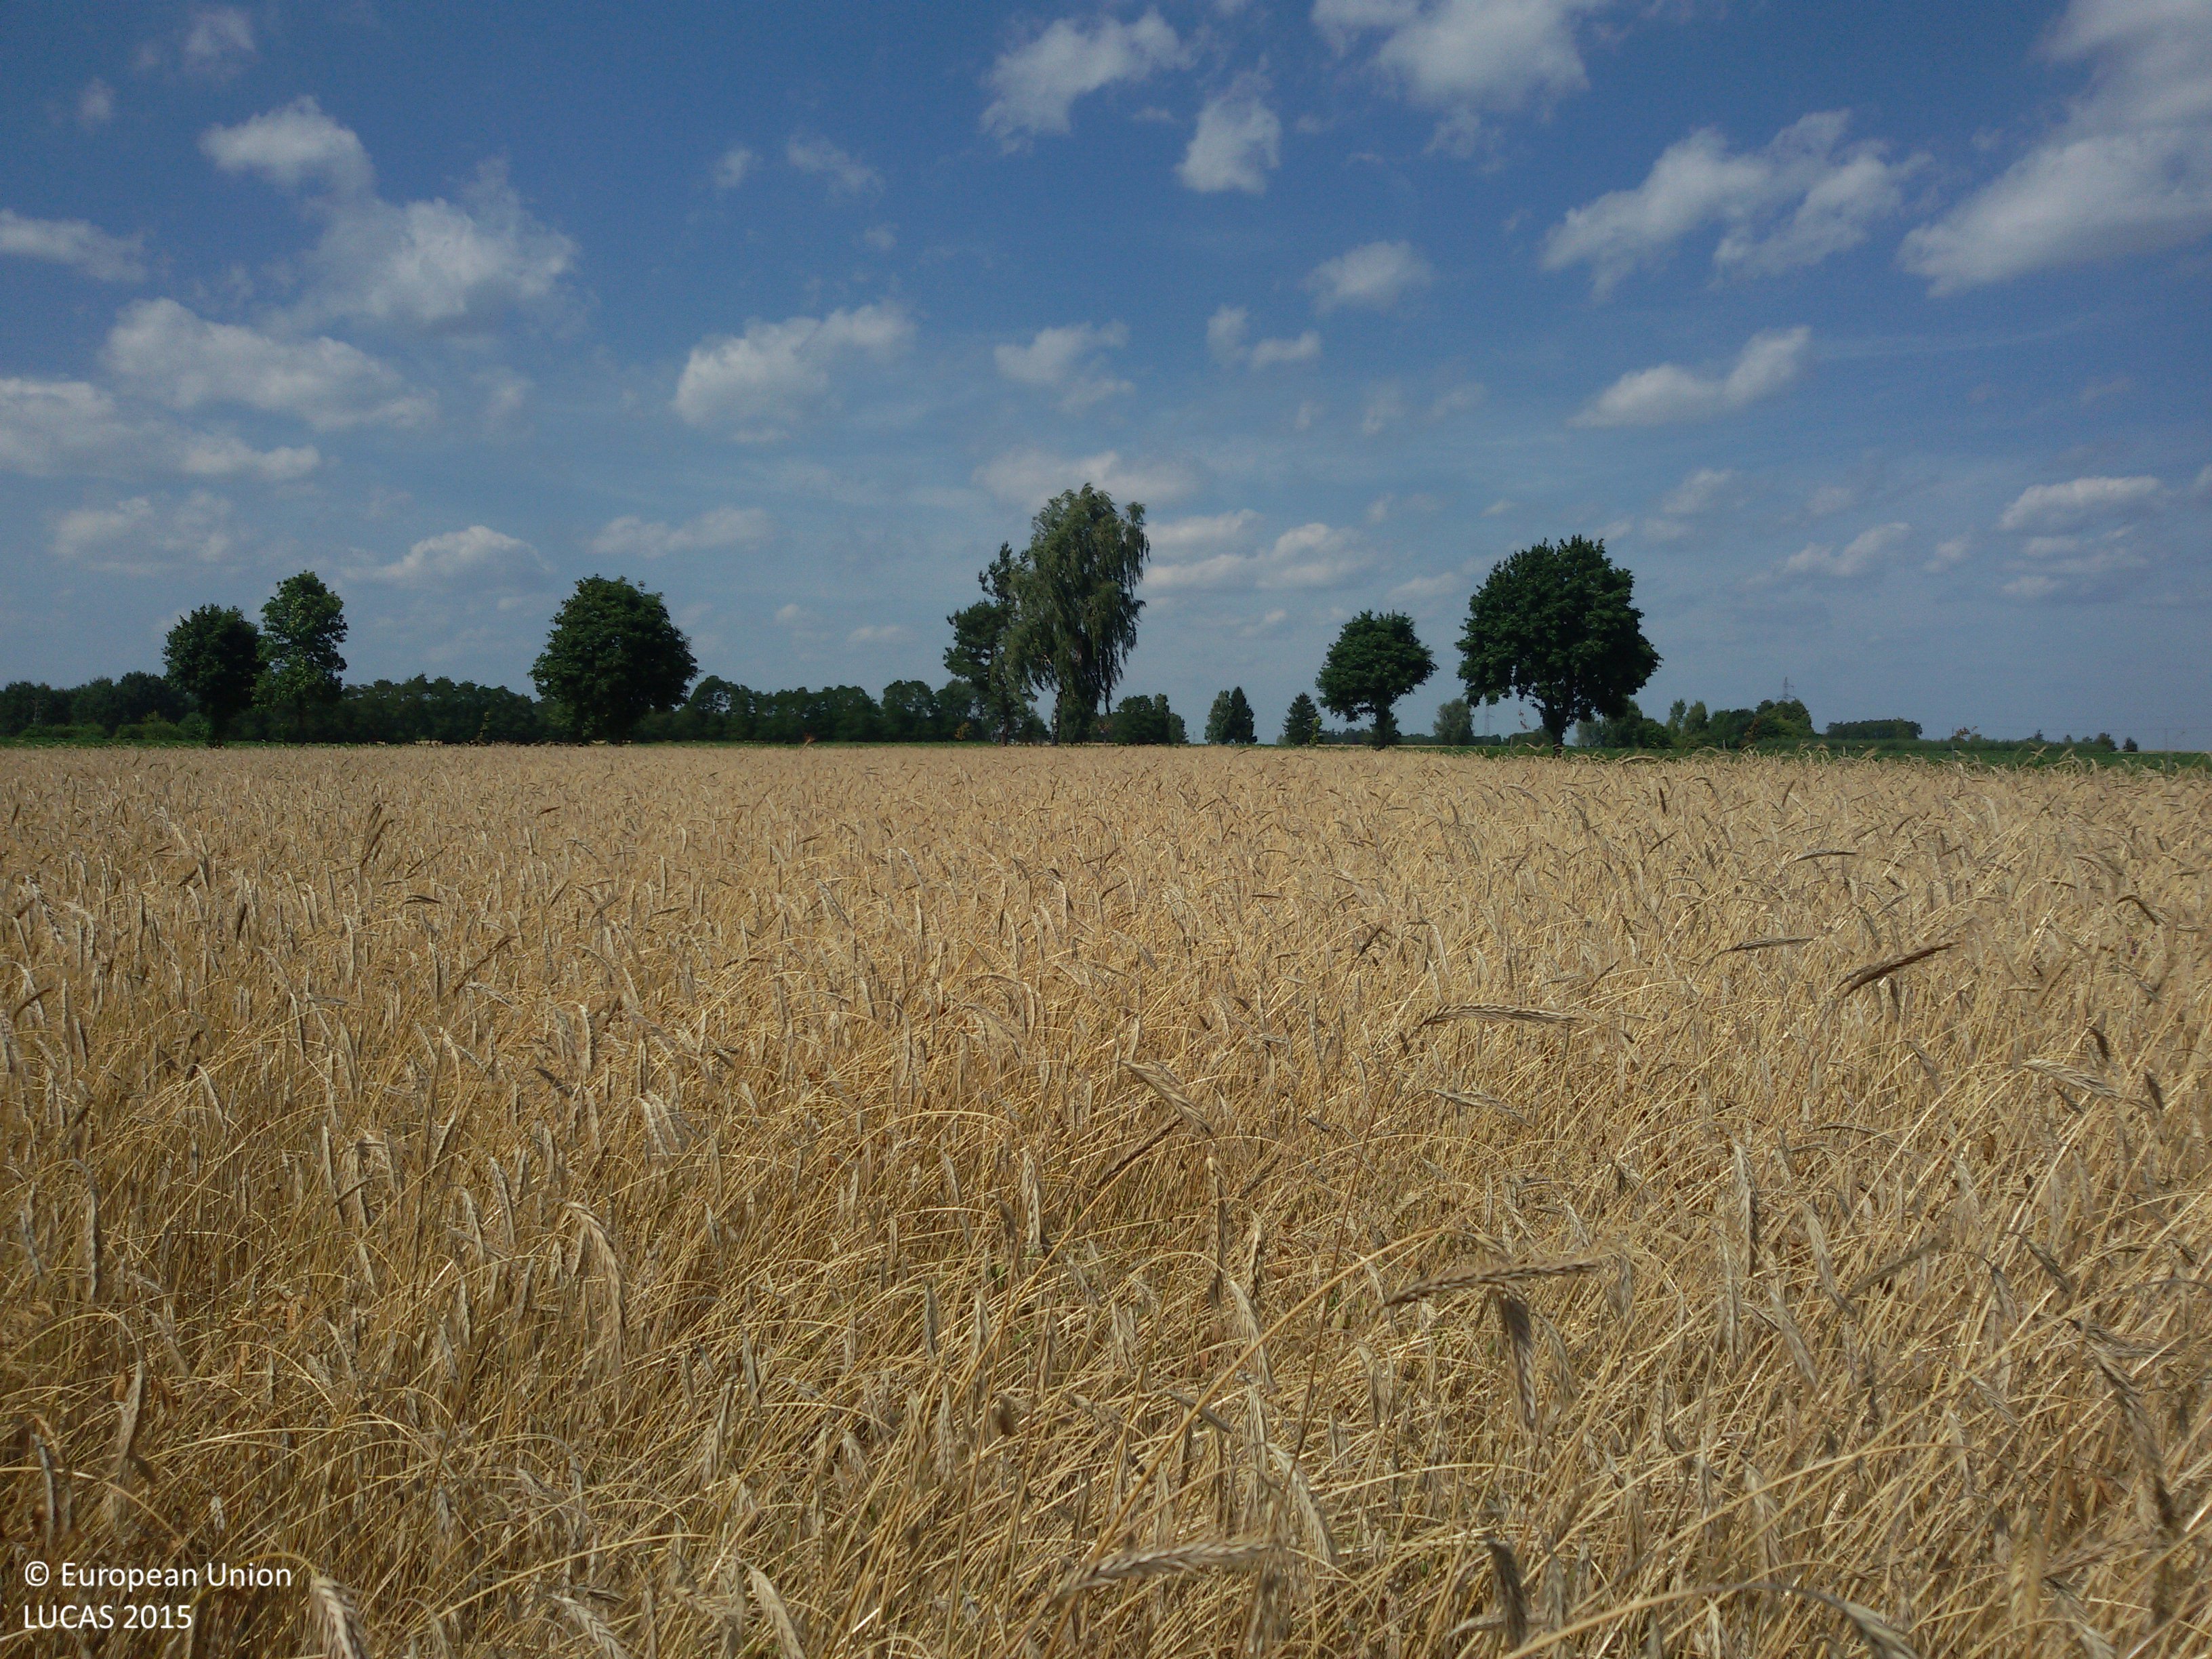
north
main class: Cropland
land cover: Rye
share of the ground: > 75 %
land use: Agriculture (excluding fallow land and kitchen gardens)
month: July
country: PL
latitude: 51.5458
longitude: 23.5097
